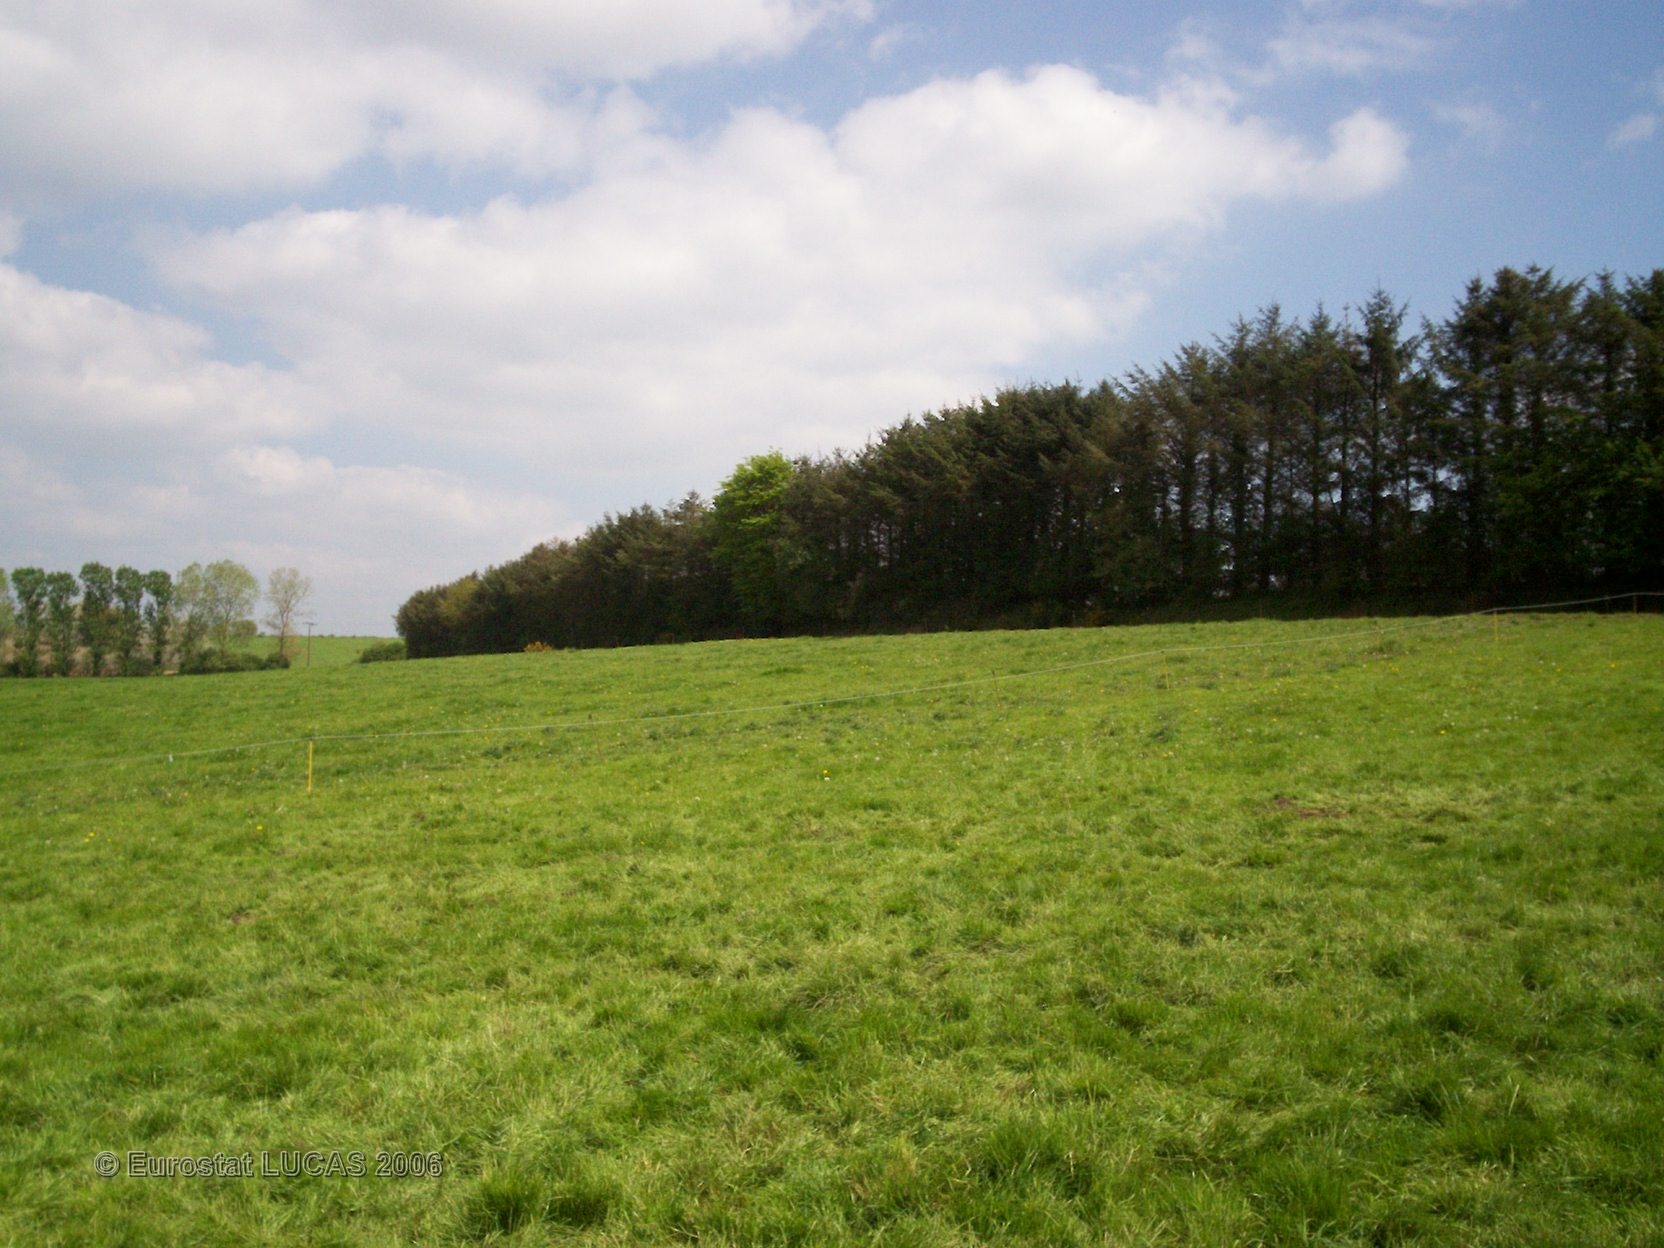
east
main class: Grassland
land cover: Grassland without tree/shrub cover
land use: Agriculture (excluding fallow land and kitchen gardens)
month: May
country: FR
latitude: 48.3523
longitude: -3.6706
